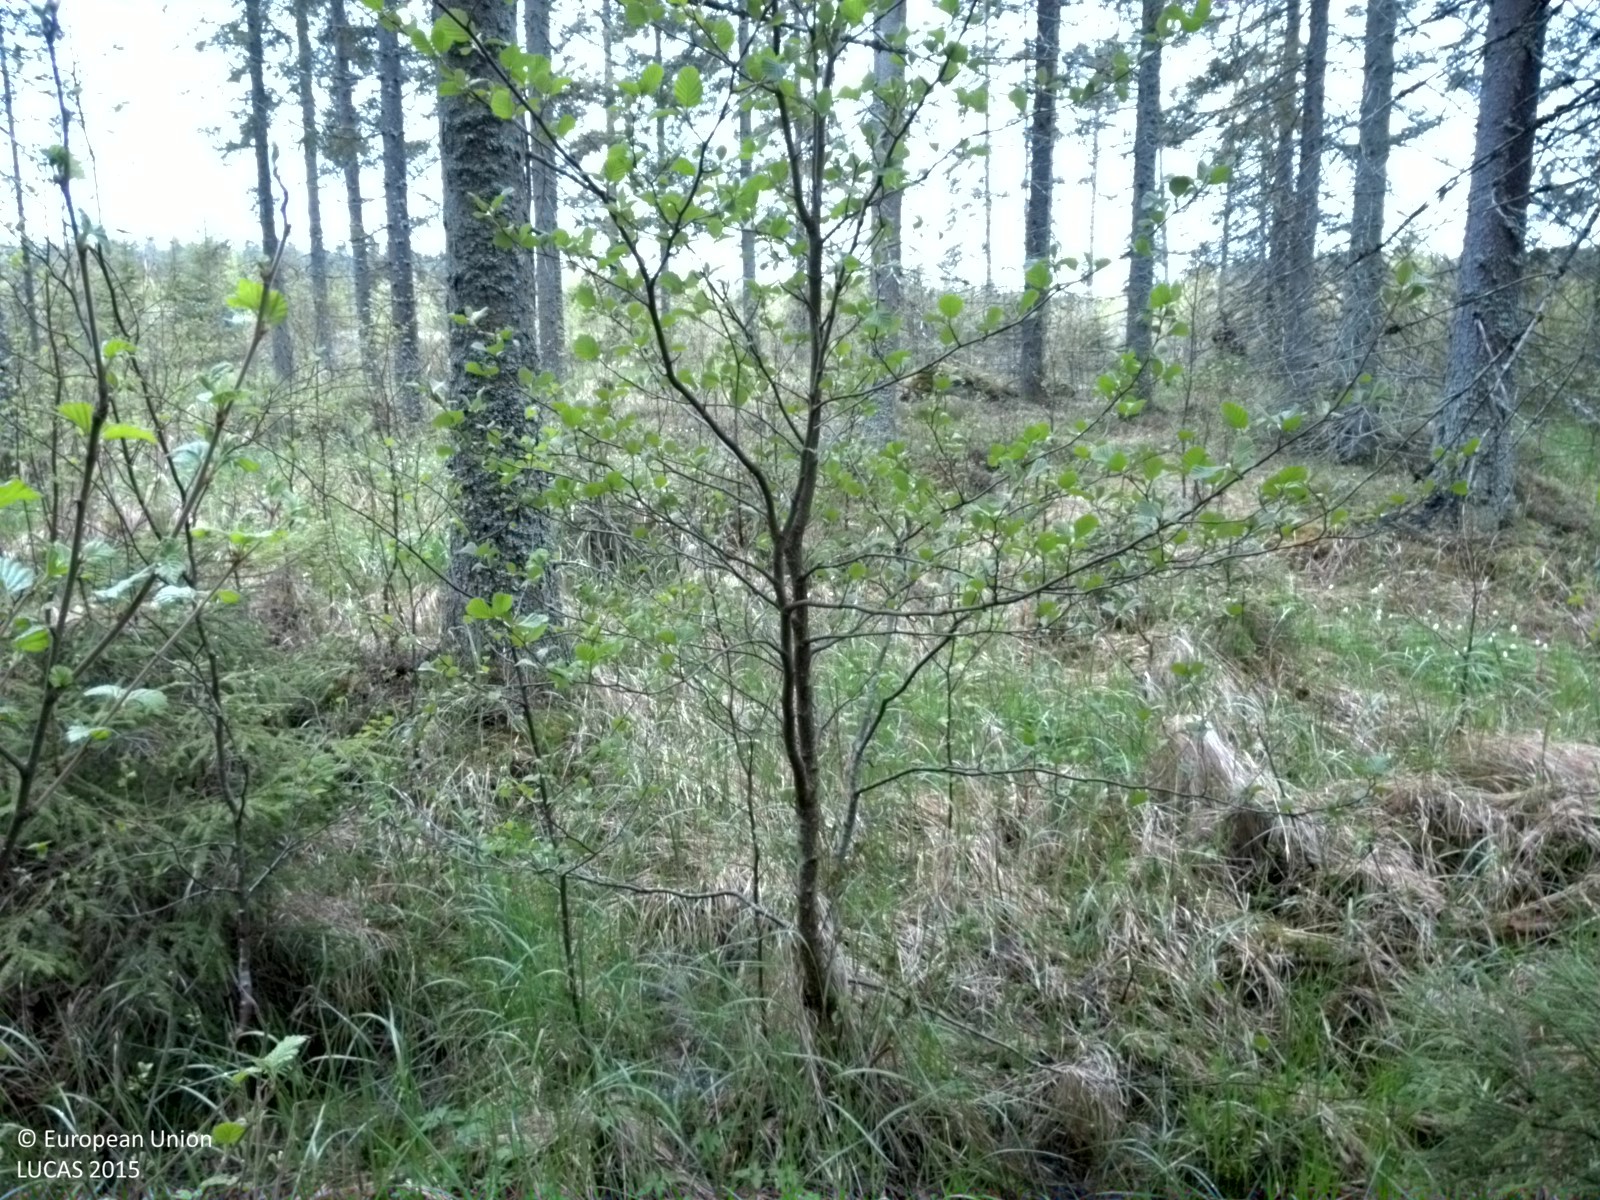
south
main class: Woodland
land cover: Spruce dominated coniferous woodland
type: boreal forest
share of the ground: > 75 %
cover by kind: coniferous forest trees 75 %, herbaceous plants 15 %, broadleaved forest trees 5 %
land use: Forestry
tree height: > 5 m
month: May
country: SE
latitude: 60.2255
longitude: 17.9916
